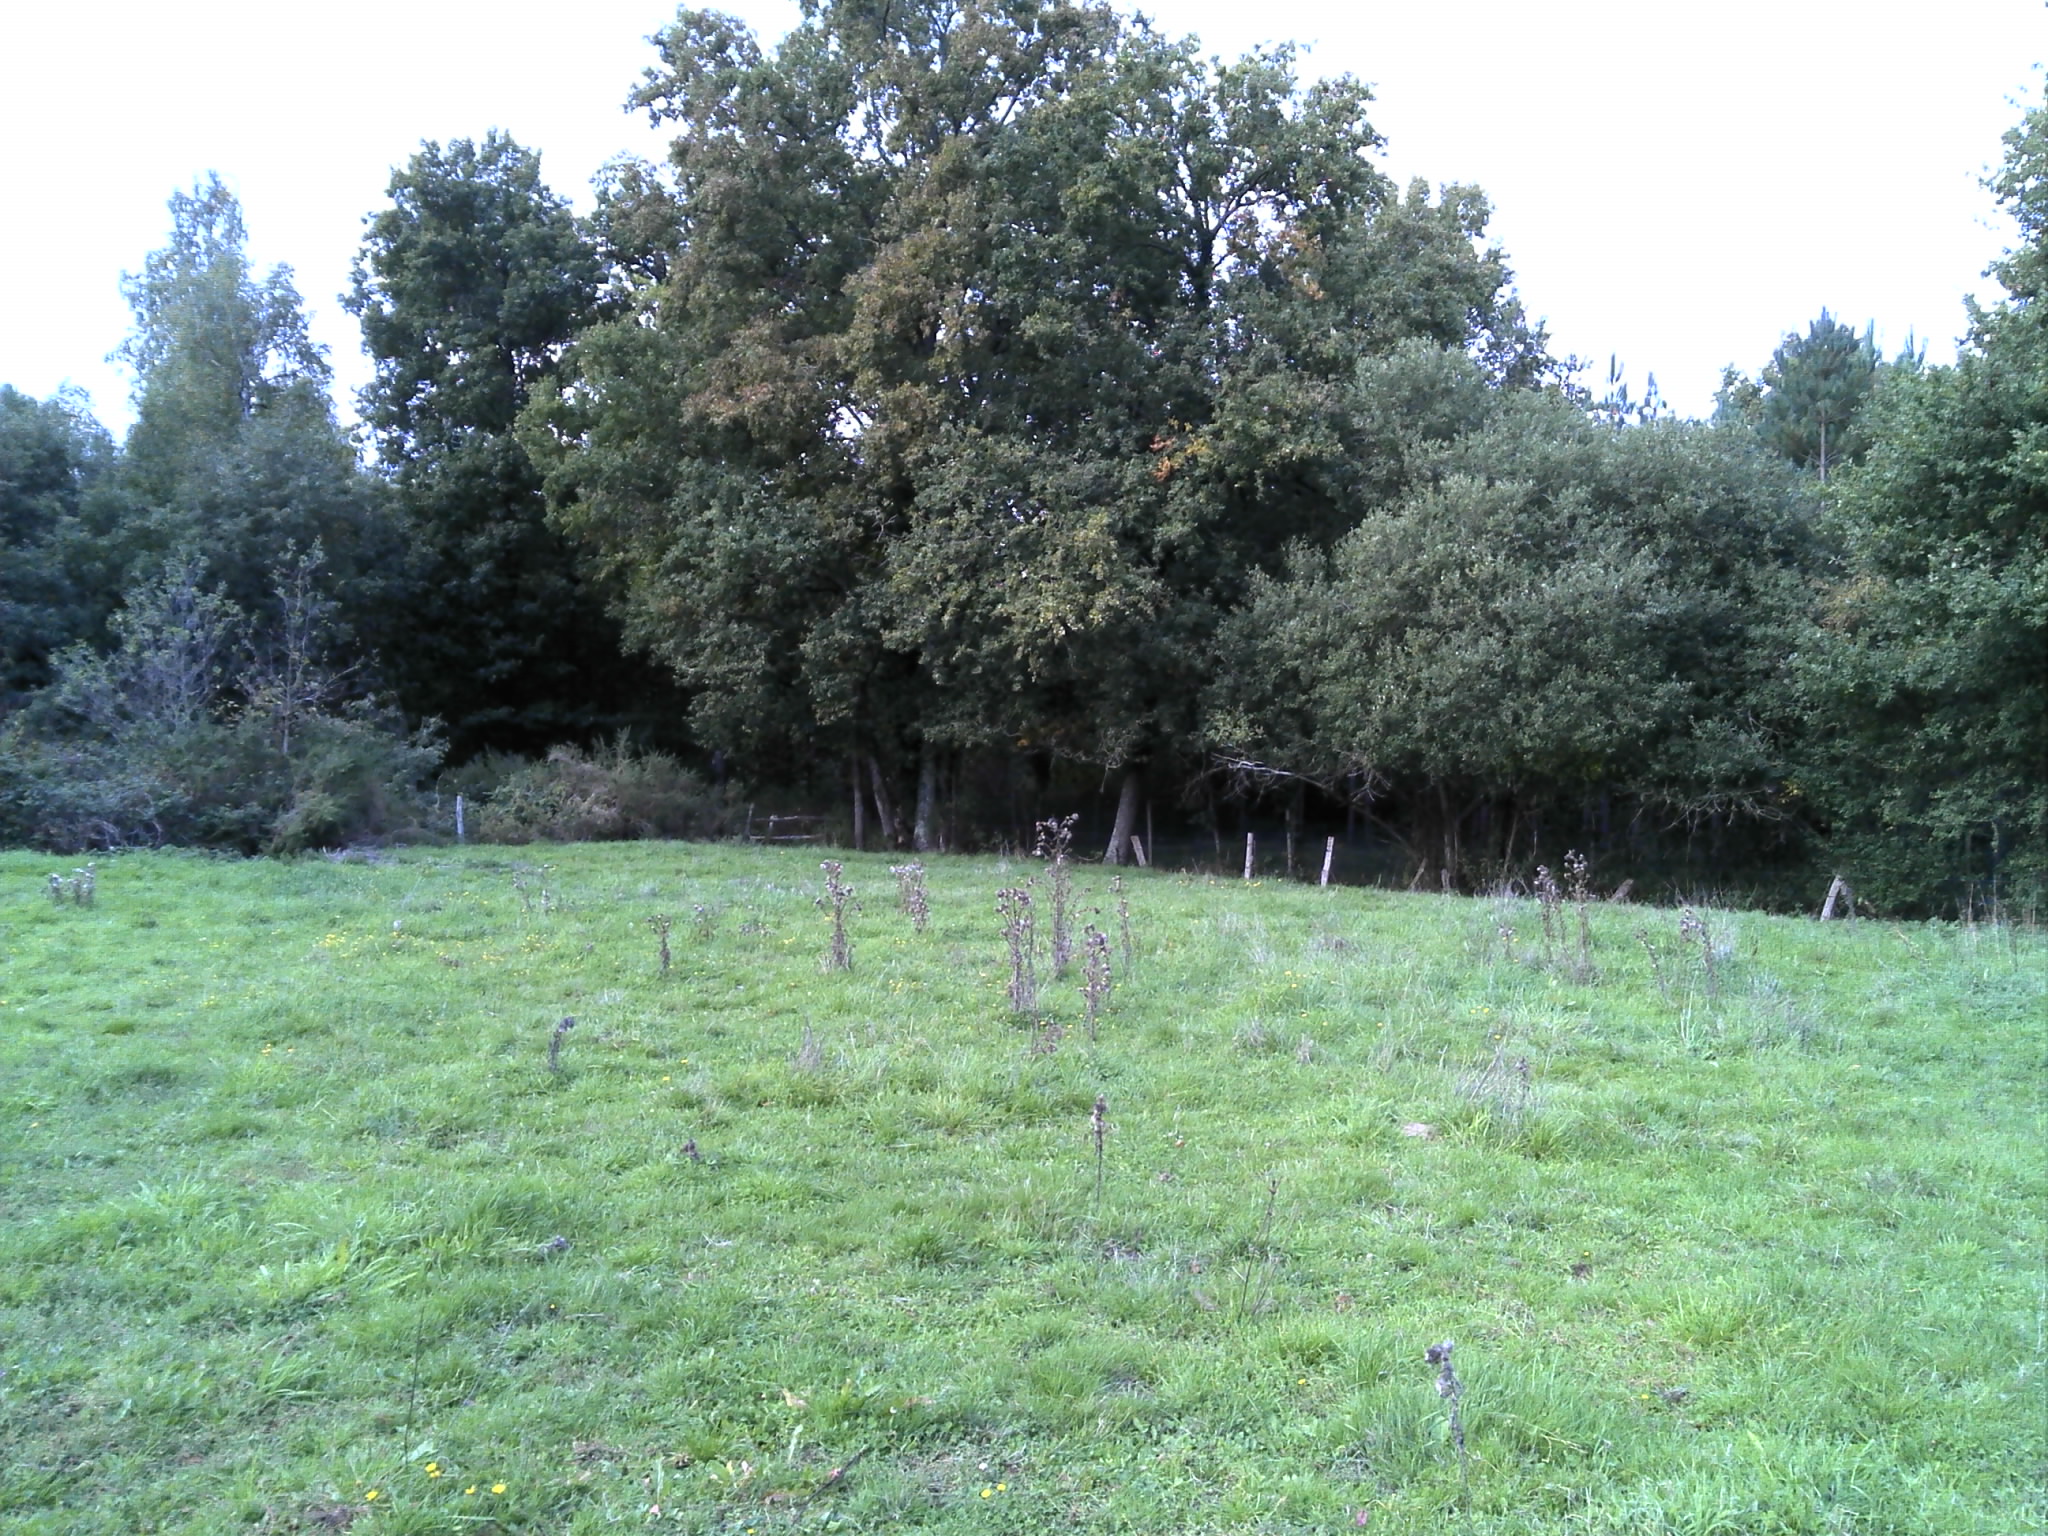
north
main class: Grassland
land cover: Grassland without tree/shrub cover
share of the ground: > 75 %
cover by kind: herbaceous plants 100 %
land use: Agriculture (excluding fallow land and kitchen gardens)
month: October
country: FR
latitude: 47.8265
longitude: 0.0482
